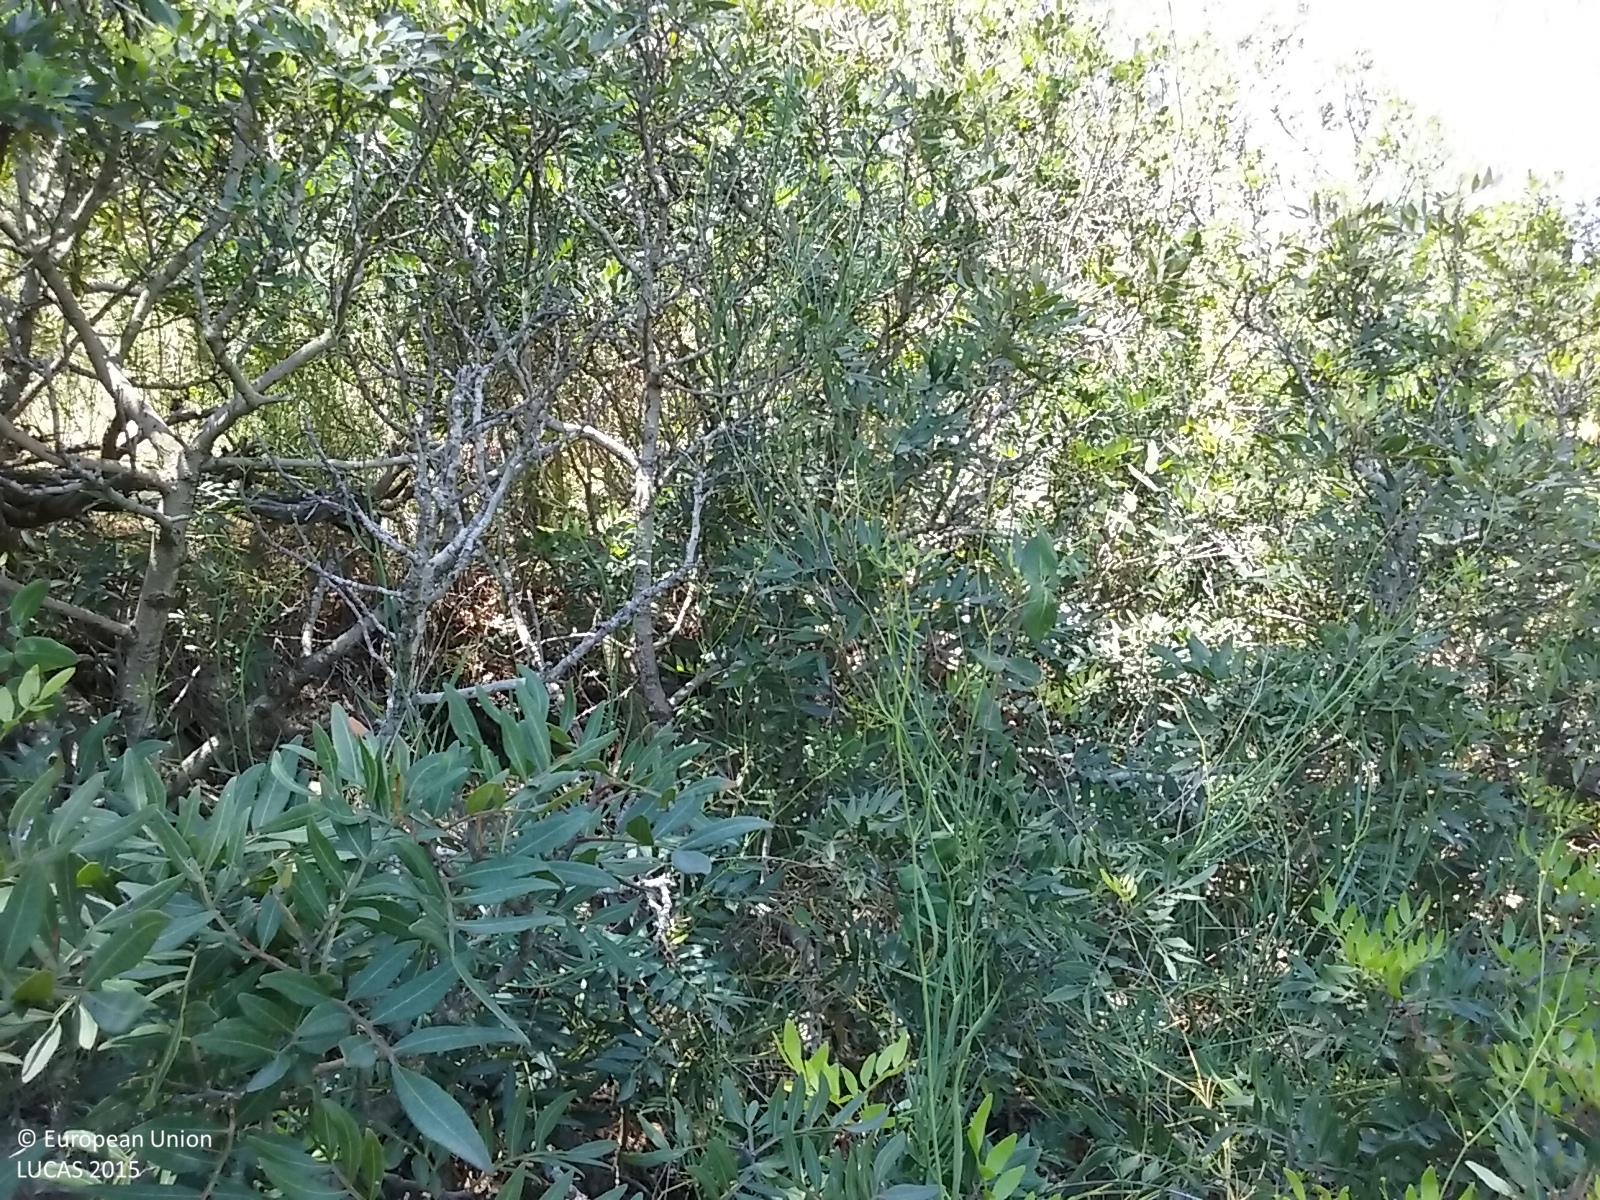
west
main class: Woodland
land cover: Pine dominated coniferous woodland
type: coniferous forest of the mediterranean region
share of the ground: > 75 %
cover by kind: coniferous forest trees 80 %, shrubs 20 %
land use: Semi-natural and natural areas not in use
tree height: > 5 m
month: June
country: ES
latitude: 41.2053
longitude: 0.4857
